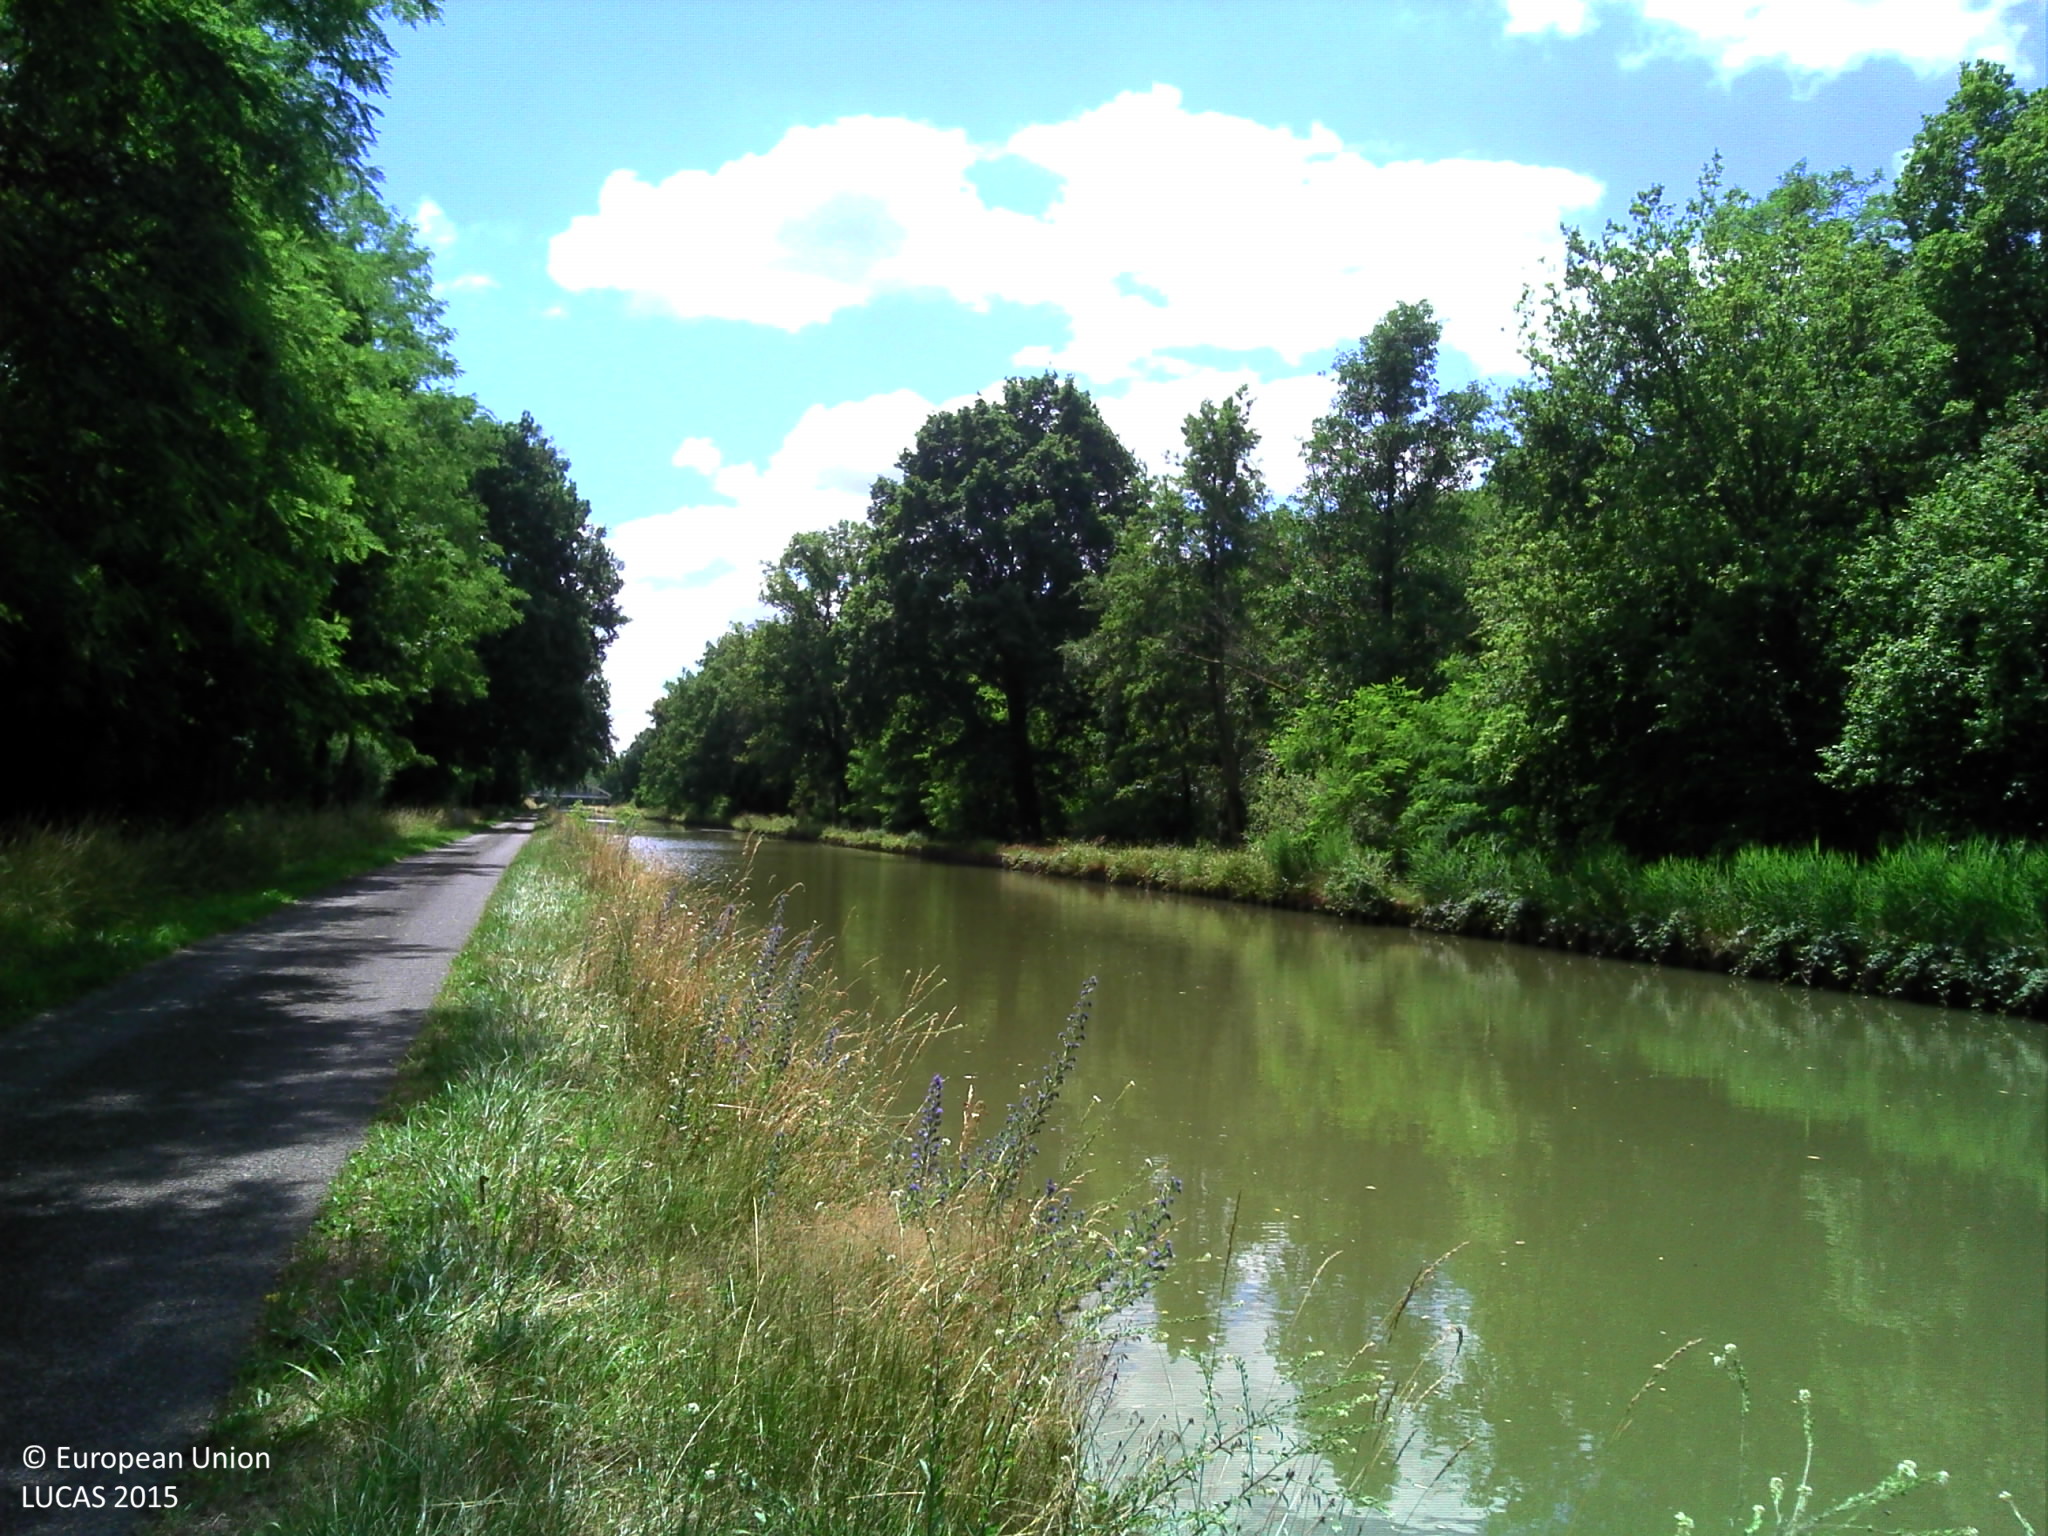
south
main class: Woodland
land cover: Broadleaved woodland
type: acidophilous oak and oak-birch forest
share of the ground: > 75 %
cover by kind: broadleaved forest trees 90 %, shrubs 5 %, herbaceous plants 5 %
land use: Semi-natural and natural areas not in use
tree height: > 5 m
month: June
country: FR
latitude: 46.6673
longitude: 3.6335
